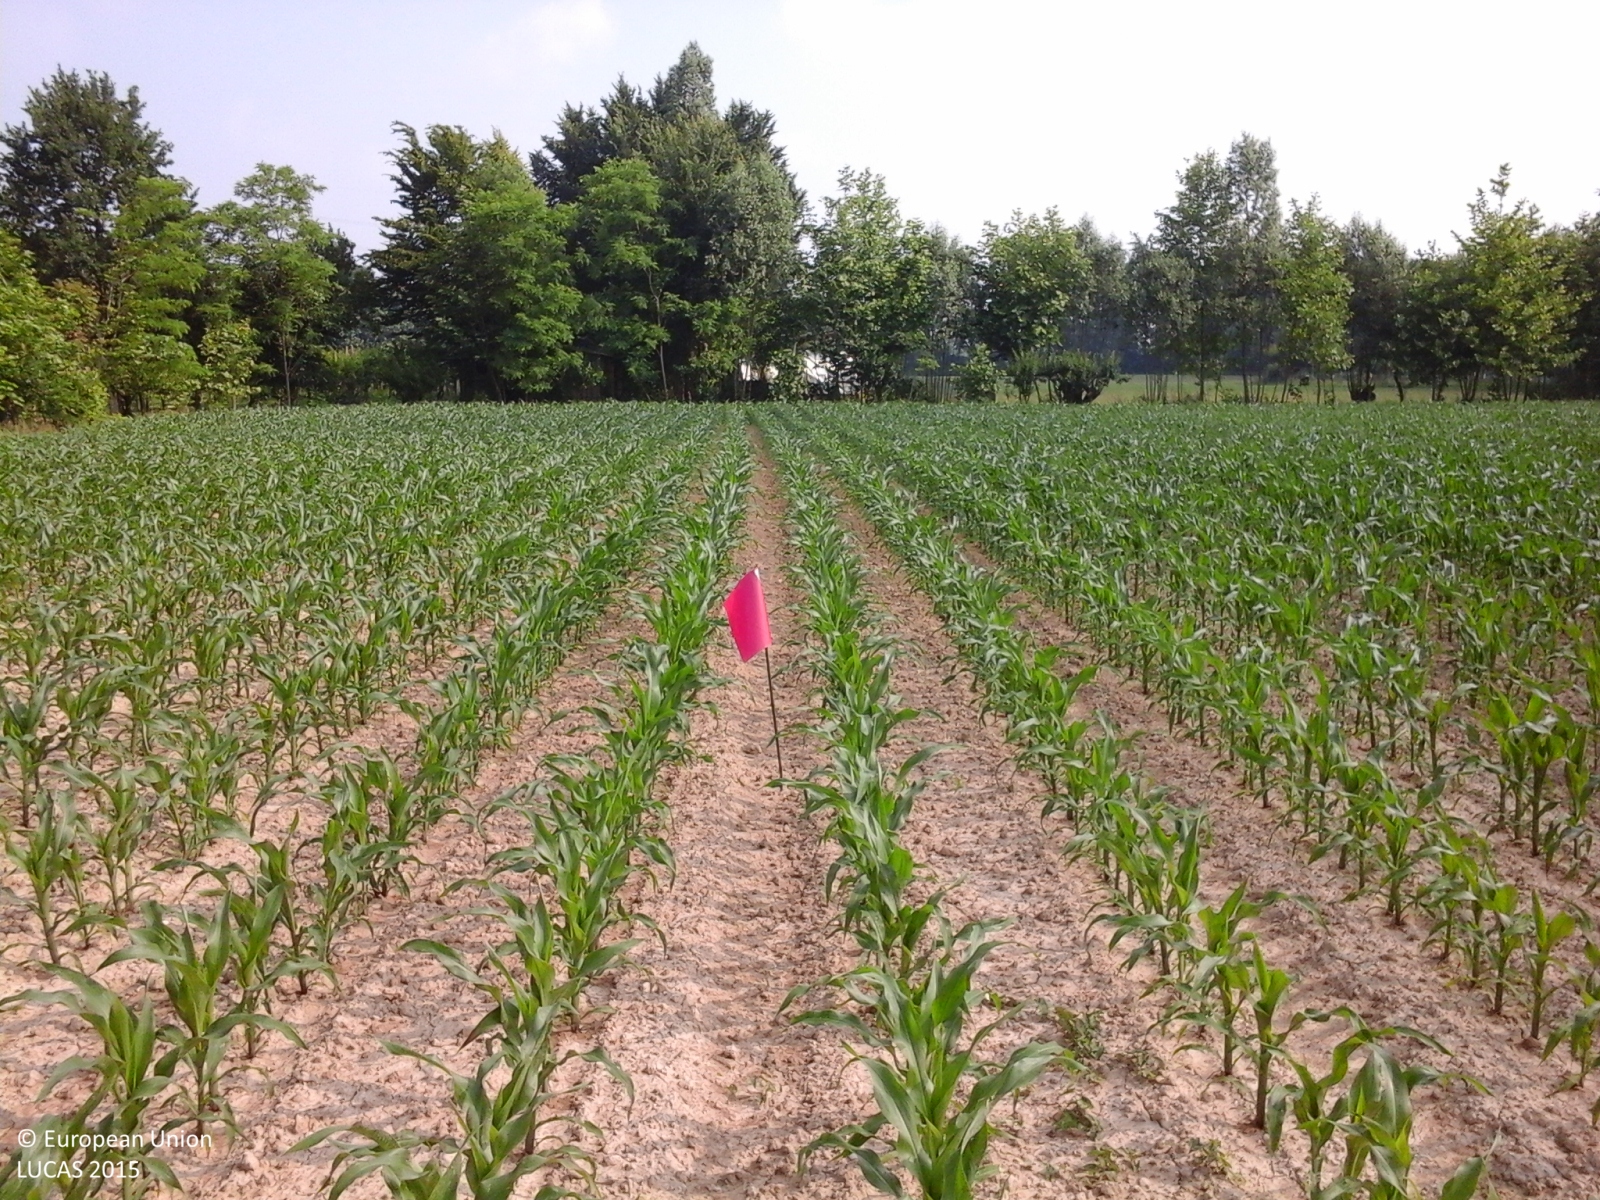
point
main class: Cropland
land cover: Maize
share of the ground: > 75 %
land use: Agriculture (excluding fallow land and kitchen gardens)
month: June
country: IT
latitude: 45.5353
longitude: 12.2120
